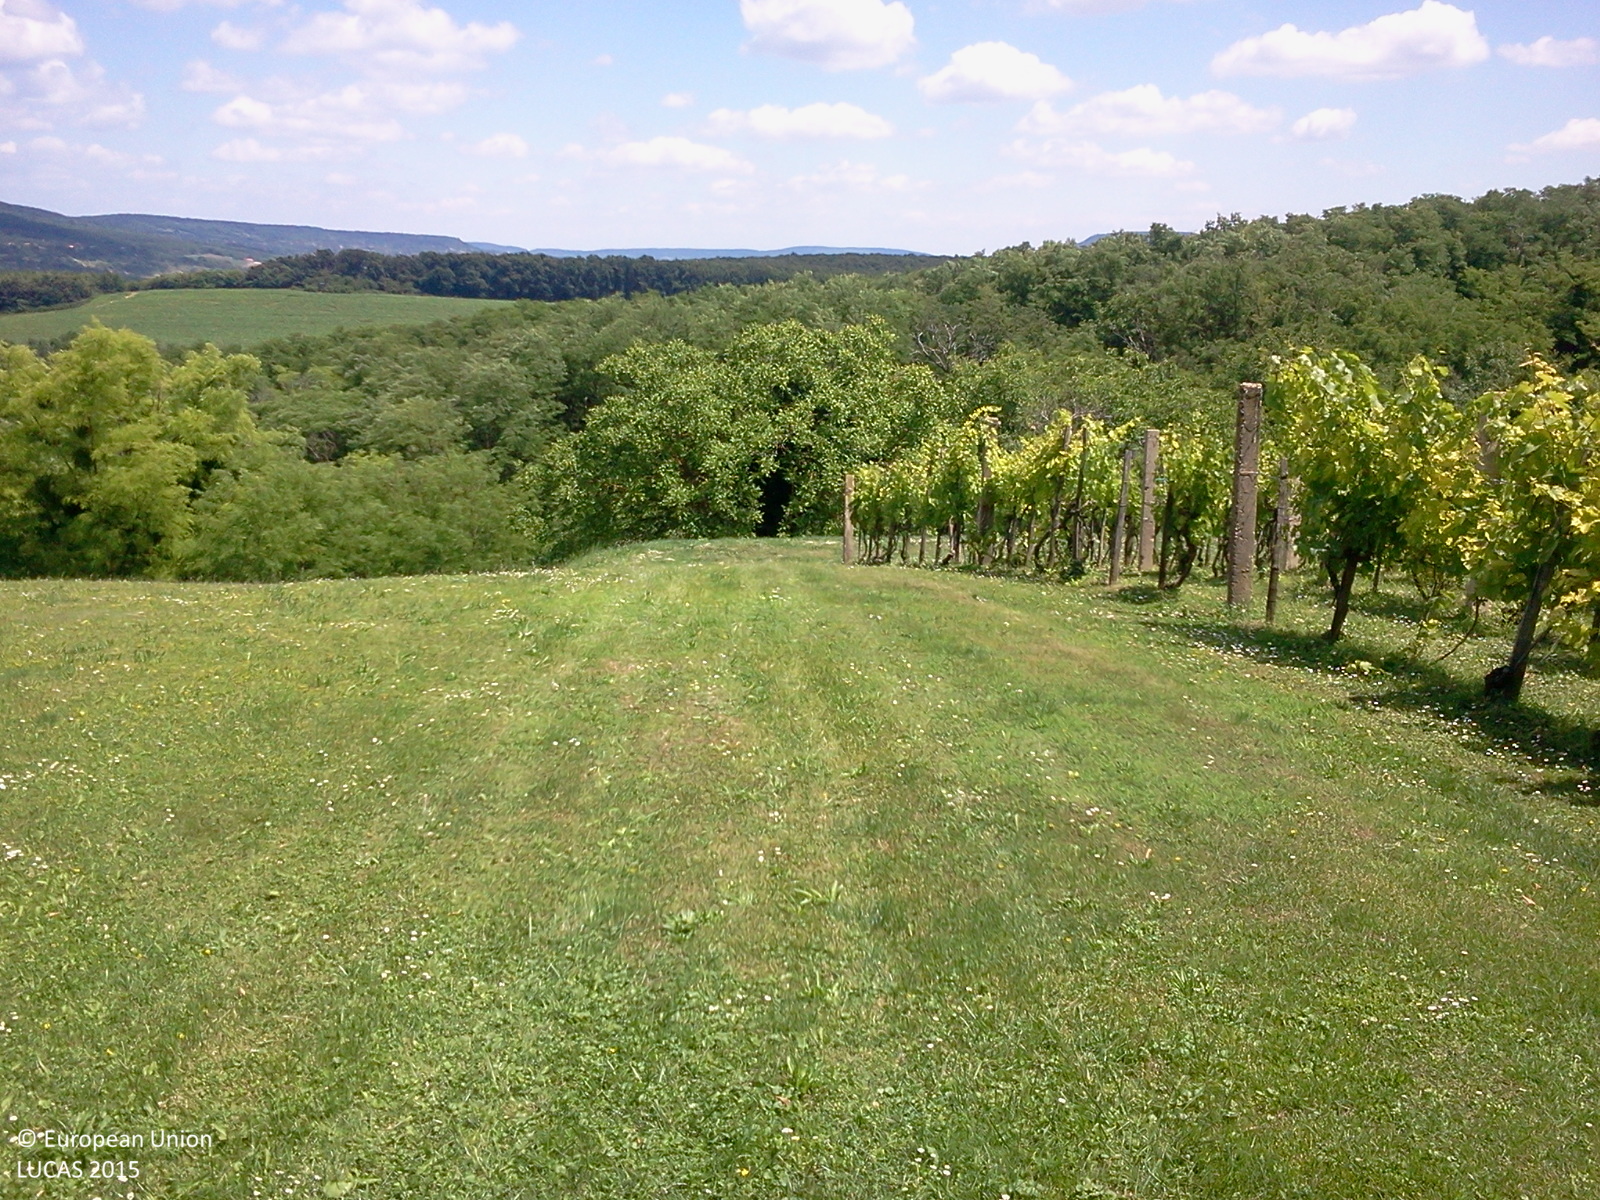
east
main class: Grassland
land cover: Grassland without tree/shrub cover
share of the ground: > 75 %
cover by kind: herbaceous plants 100 %
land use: Agriculture (excluding fallow land and kitchen gardens)
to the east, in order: Grassland without tree/shrub cover; Cherry fruit; Broadleaved woodland
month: June
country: HU
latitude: 46.8903
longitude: 17.1311
